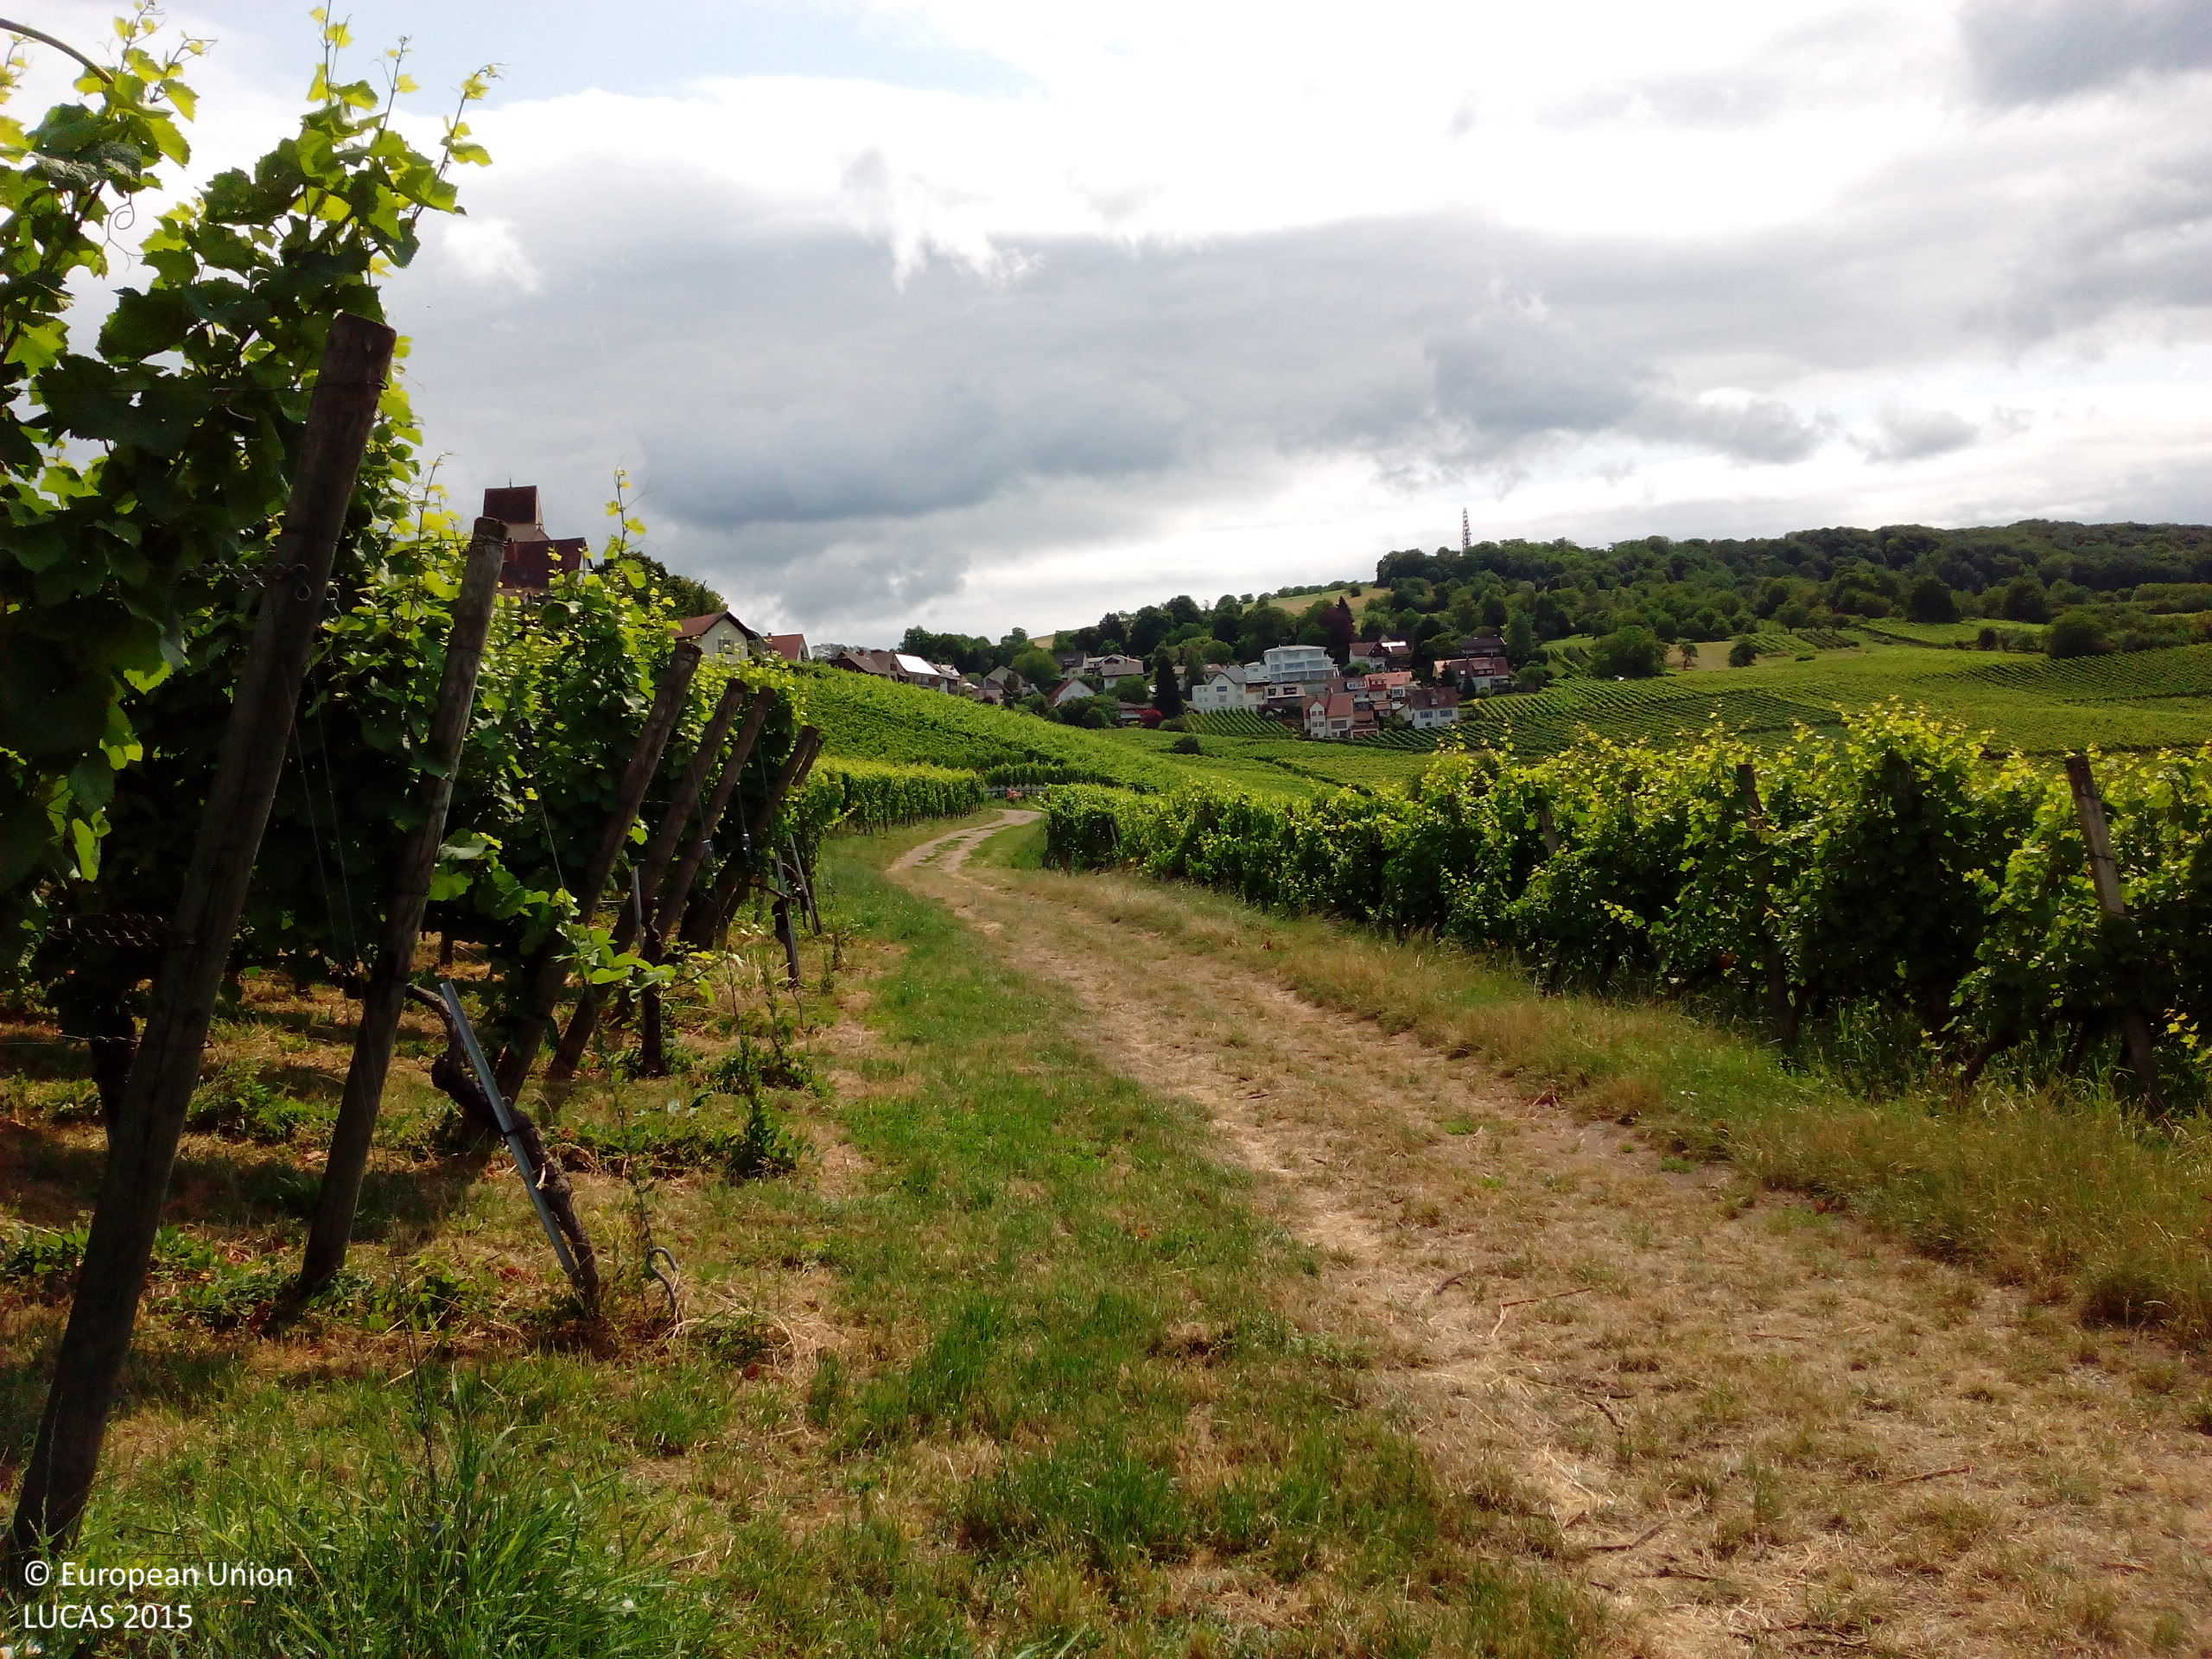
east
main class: Cropland
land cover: Vineyards
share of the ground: 25 - 50 %
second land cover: Grassland without tree/shrub cover
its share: 50 - 75 %
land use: Agriculture (excluding fallow land and kitchen gardens)
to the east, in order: Vineyards; Grassland without tree/shrub cover; Tracks; Vineyards; Tracks; Vineyards; Grassland without tree/shrub cover; Paved roads, cycling and walking lanes; Grass margins; Vineyards; Tracks; Vineyards
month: July
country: DE
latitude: 47.6217
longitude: 7.6198
